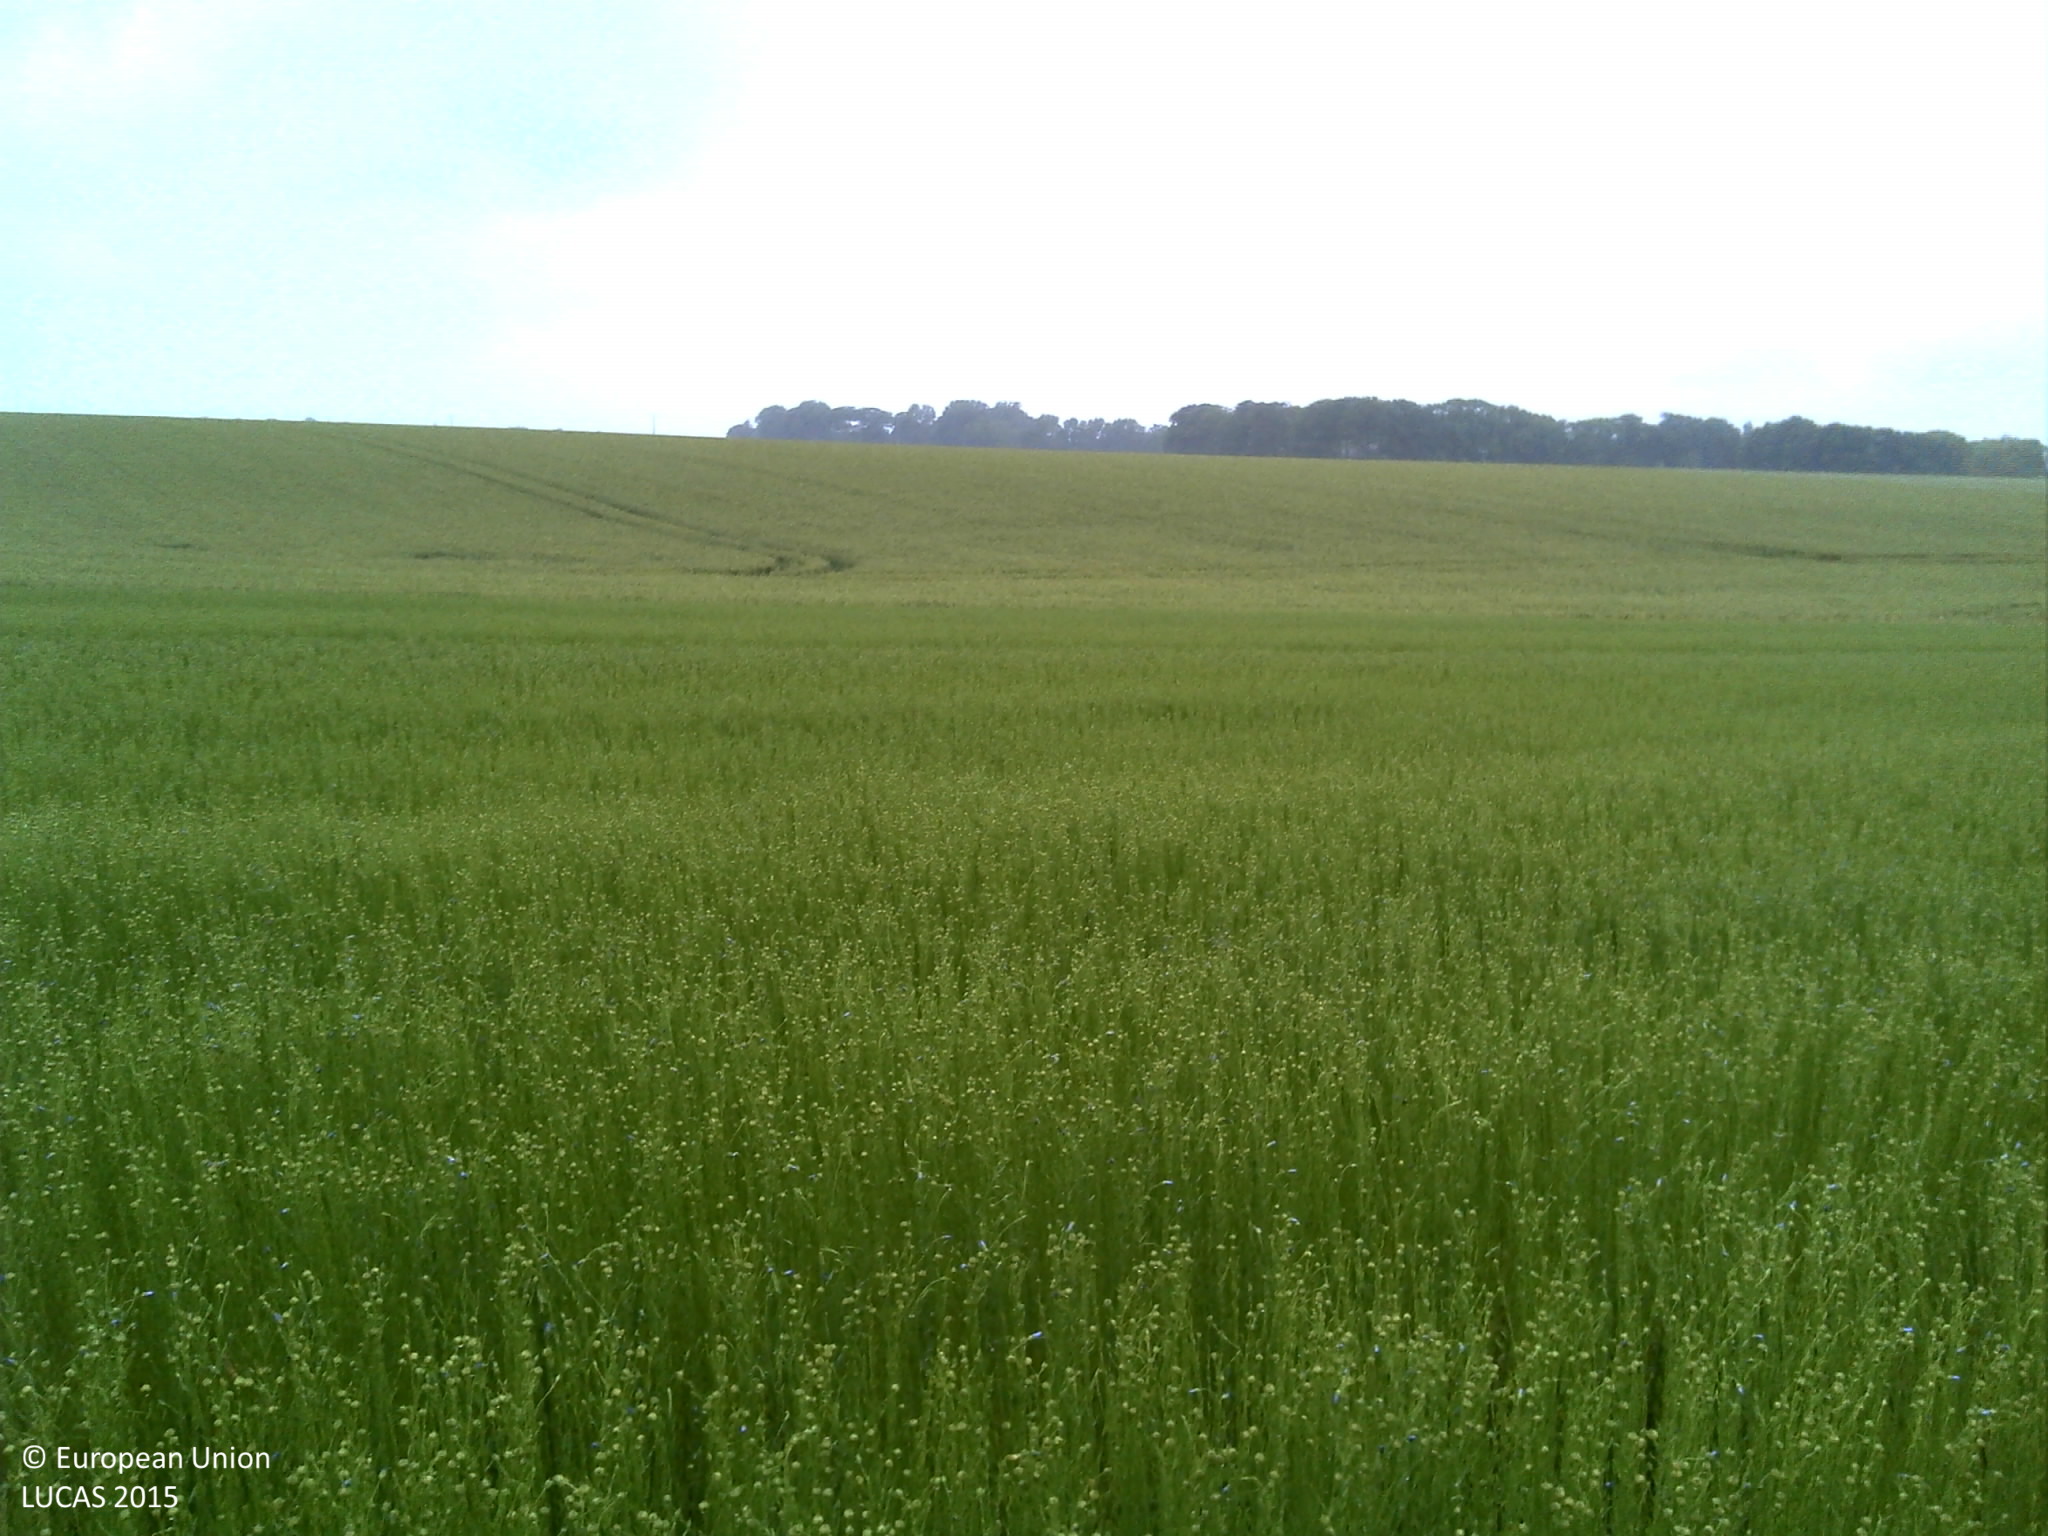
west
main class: Cropland
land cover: Other fibre and oleaginous crops
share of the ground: > 75 %
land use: Agriculture (excluding fallow land and kitchen gardens)
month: June
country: FR
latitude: 49.7134
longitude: 0.2768
